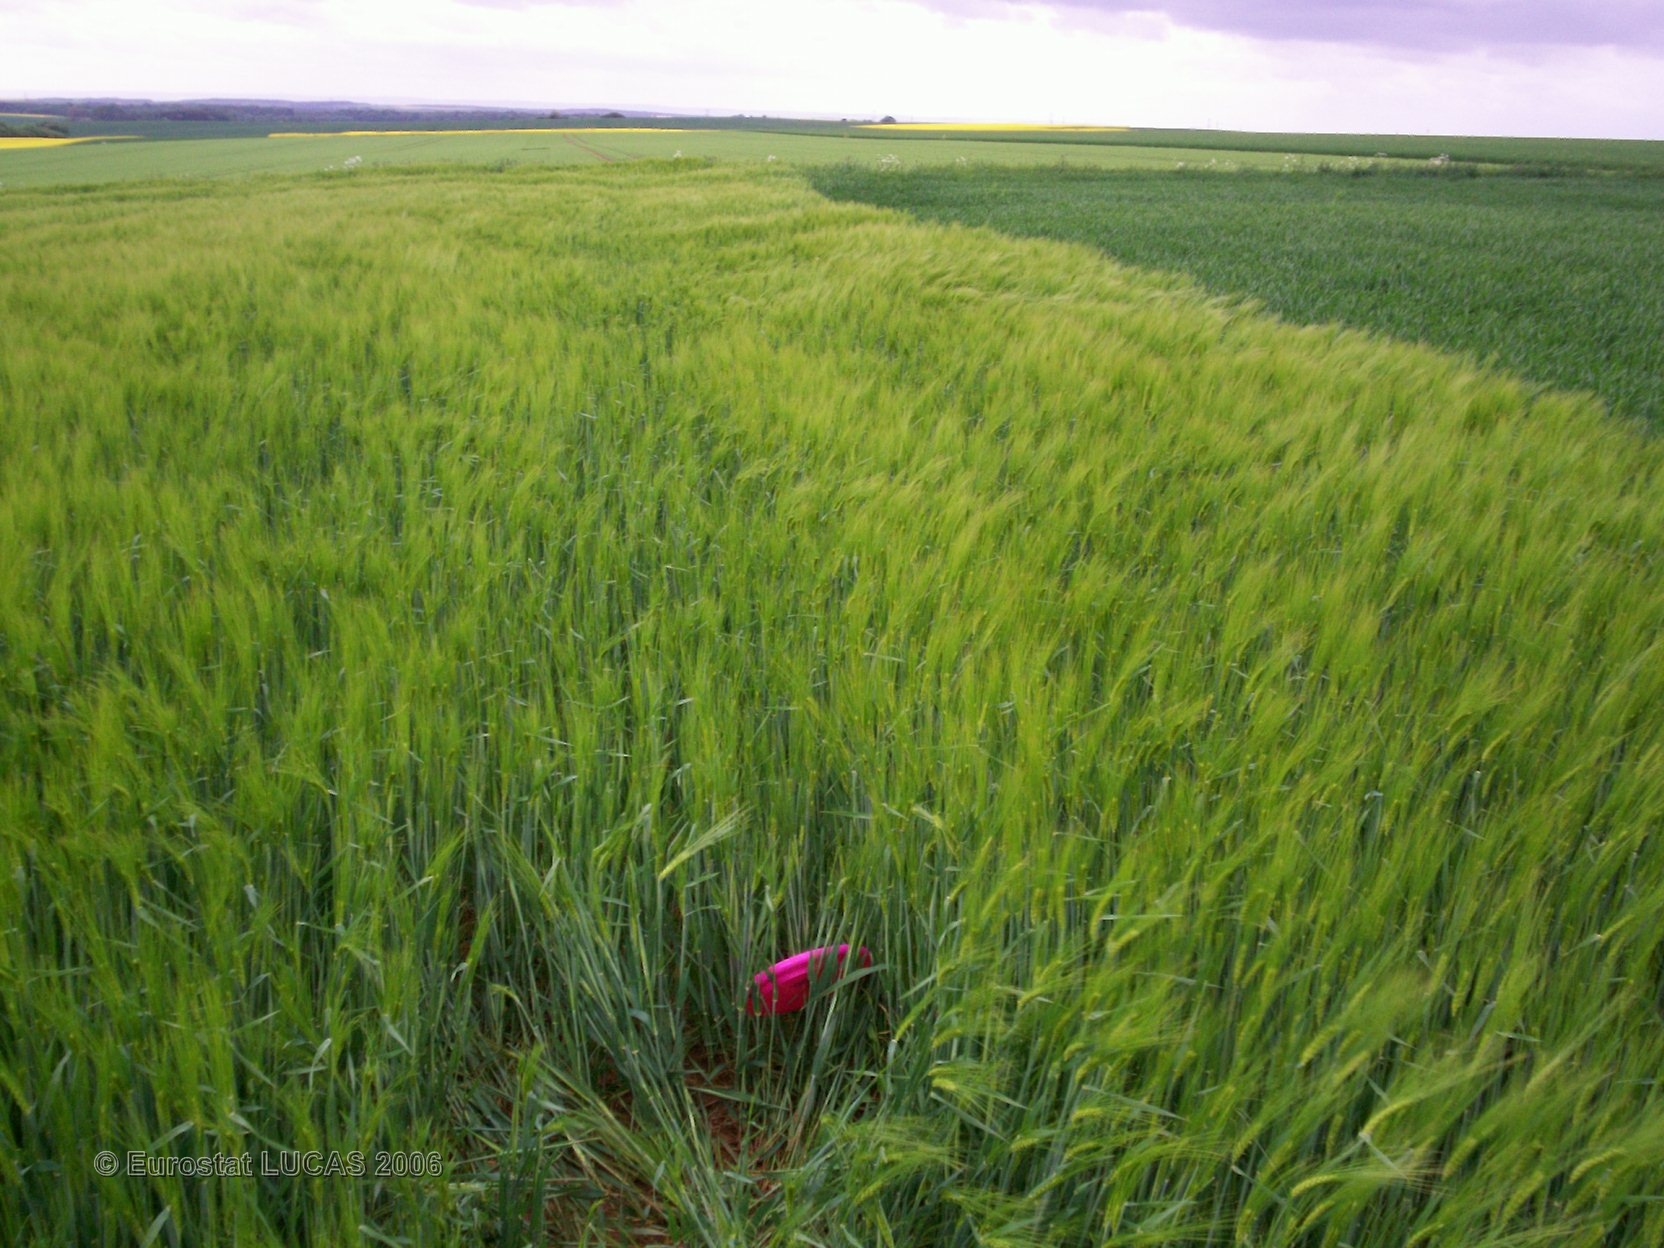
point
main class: Cropland
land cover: Barley
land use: Agriculture (excluding fallow land and kitchen gardens)
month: May
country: FR
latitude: 49.4244
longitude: 5.8493
